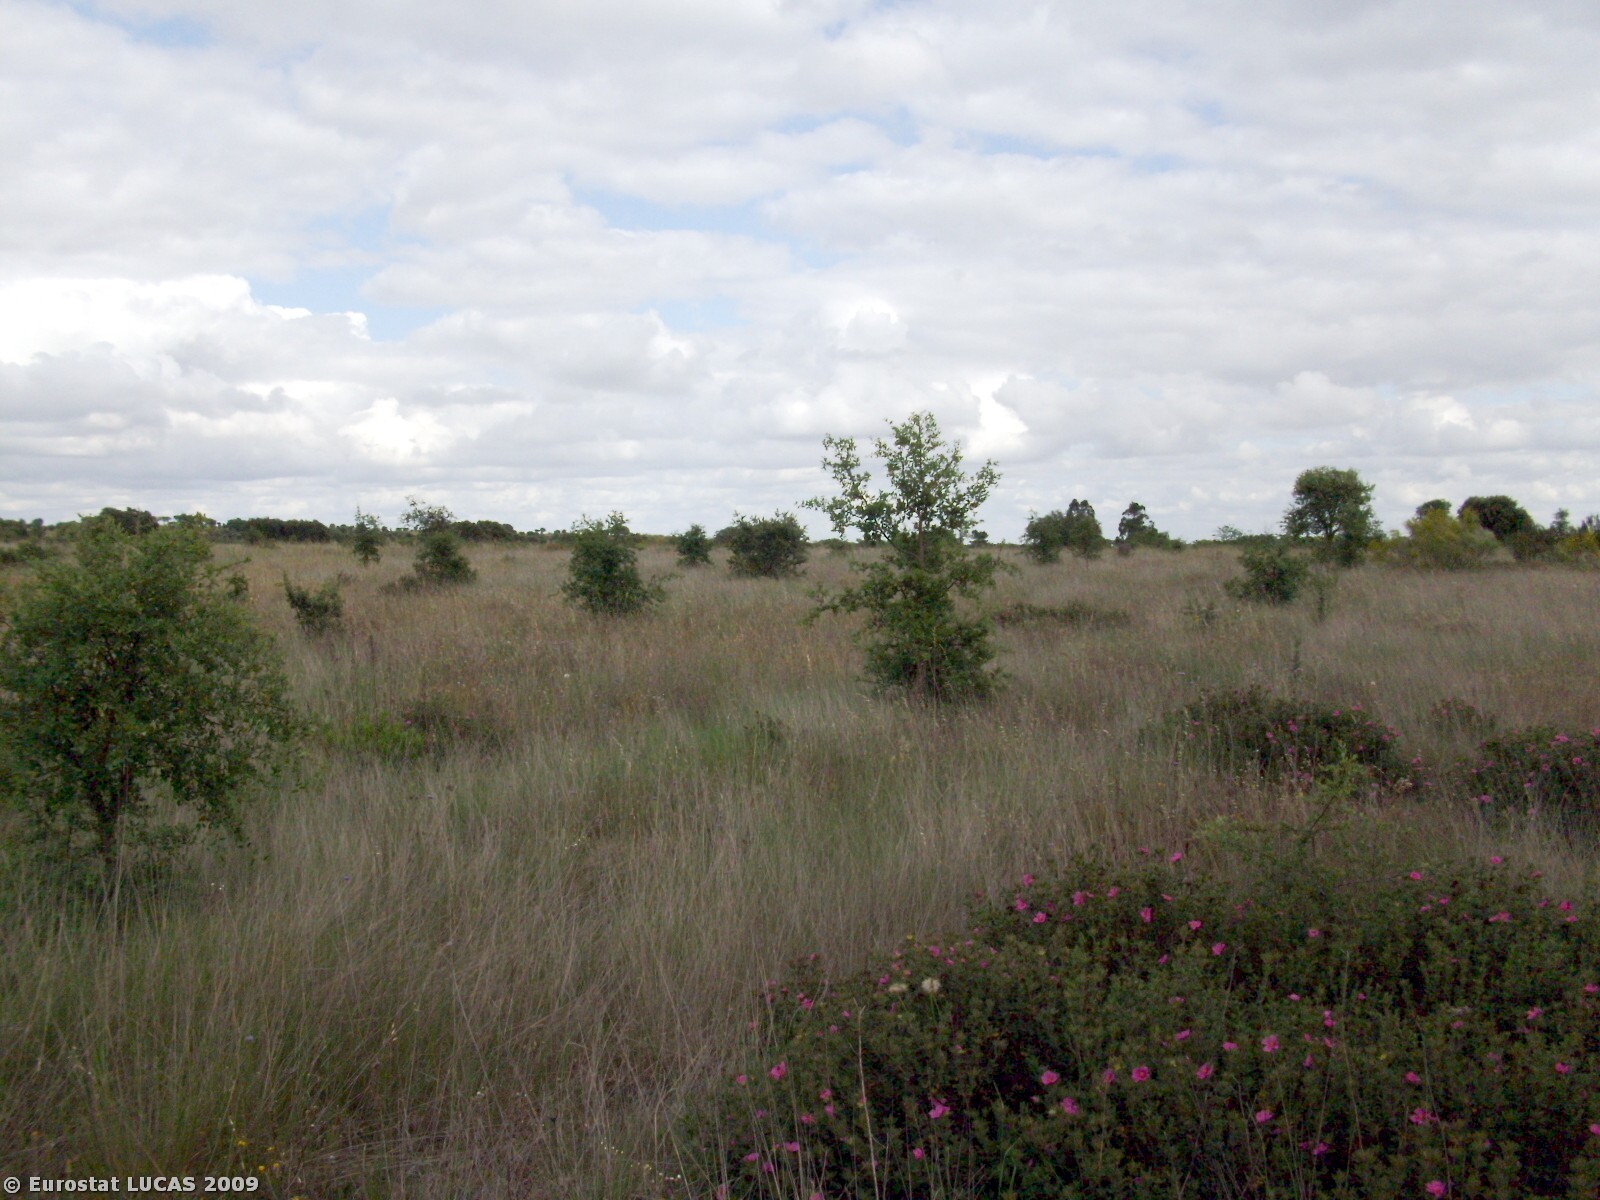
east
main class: Woodland
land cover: Broadleaved woodland
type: broadleaved evergreen forest
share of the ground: 10 - 25 %
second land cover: Spontaneously vegetated surfaces
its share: 50 - 75 %
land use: Forestry
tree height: > 5 m
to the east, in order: Broadleaved woodland; Spontaneously vegetated surfaces; Broadleaved woodland
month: May
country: PT
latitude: 39.2286
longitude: -7.8315
